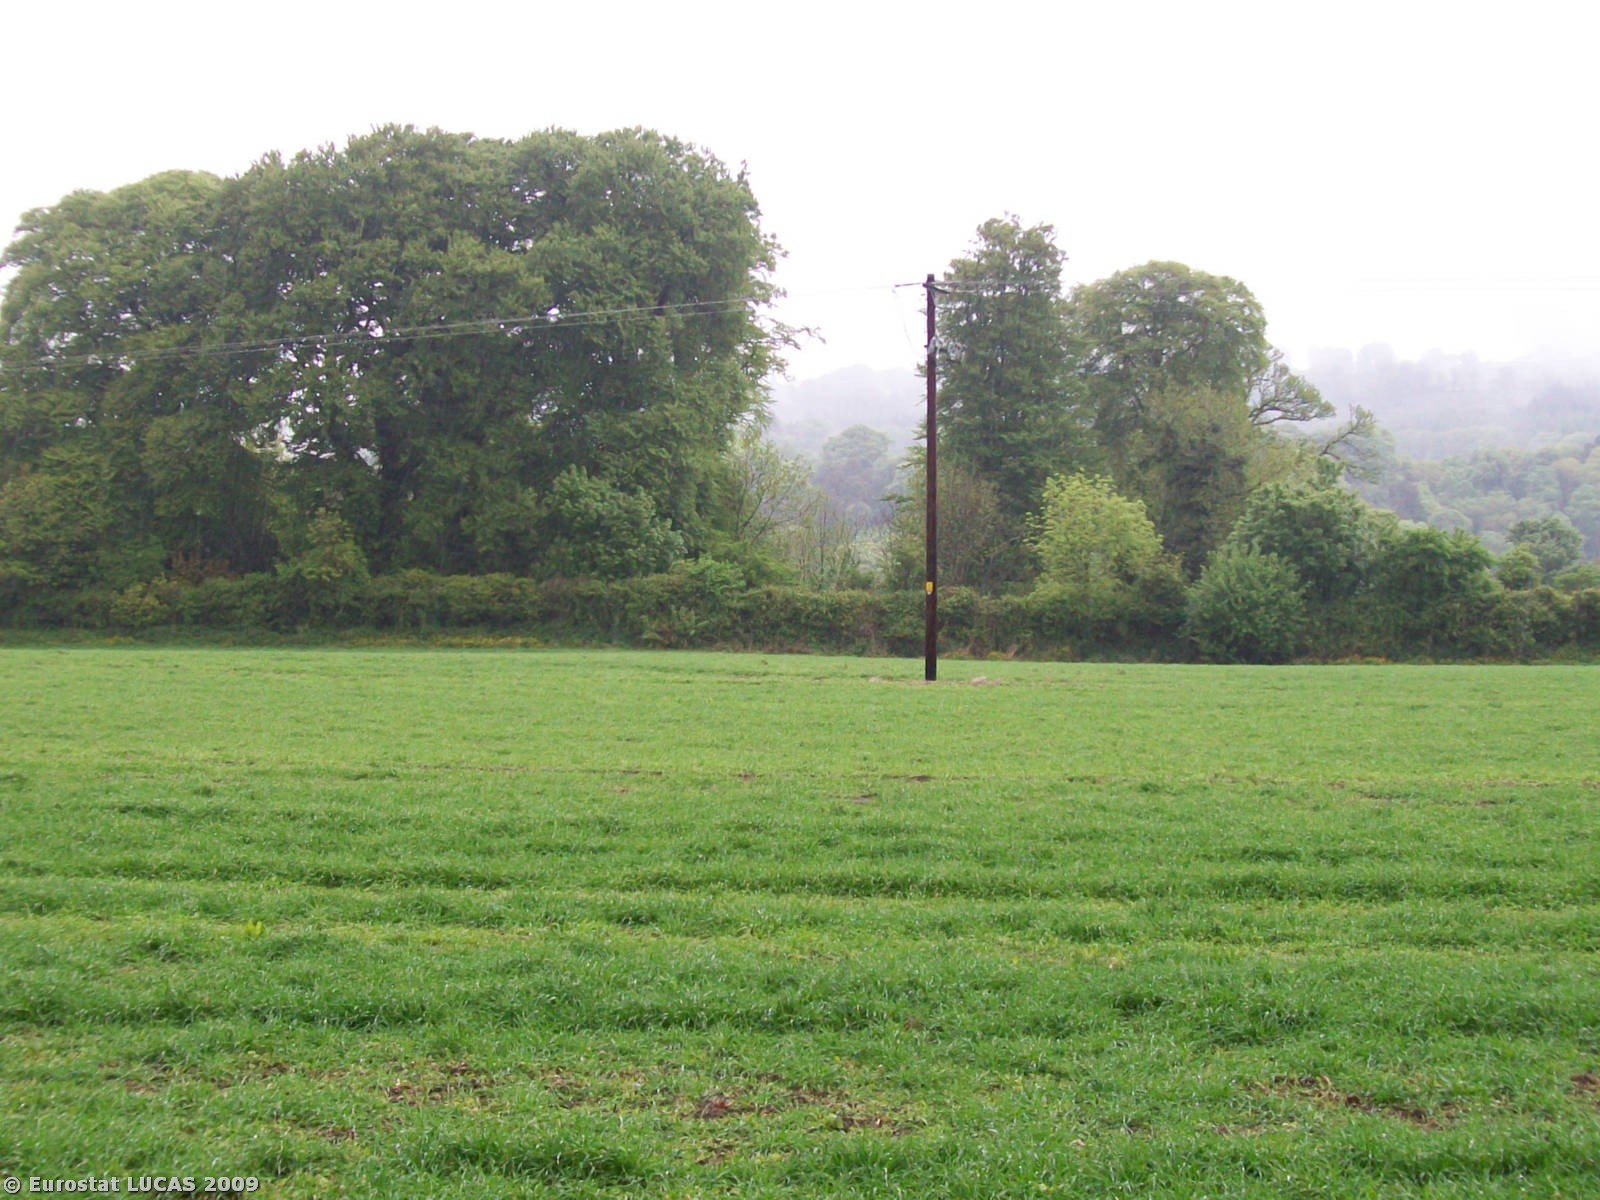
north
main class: Grassland
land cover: Grassland without tree/shrub cover
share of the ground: > 75 %
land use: Agriculture (excluding fallow land and kitchen gardens)
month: May
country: IE
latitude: 52.1397
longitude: -7.9264
